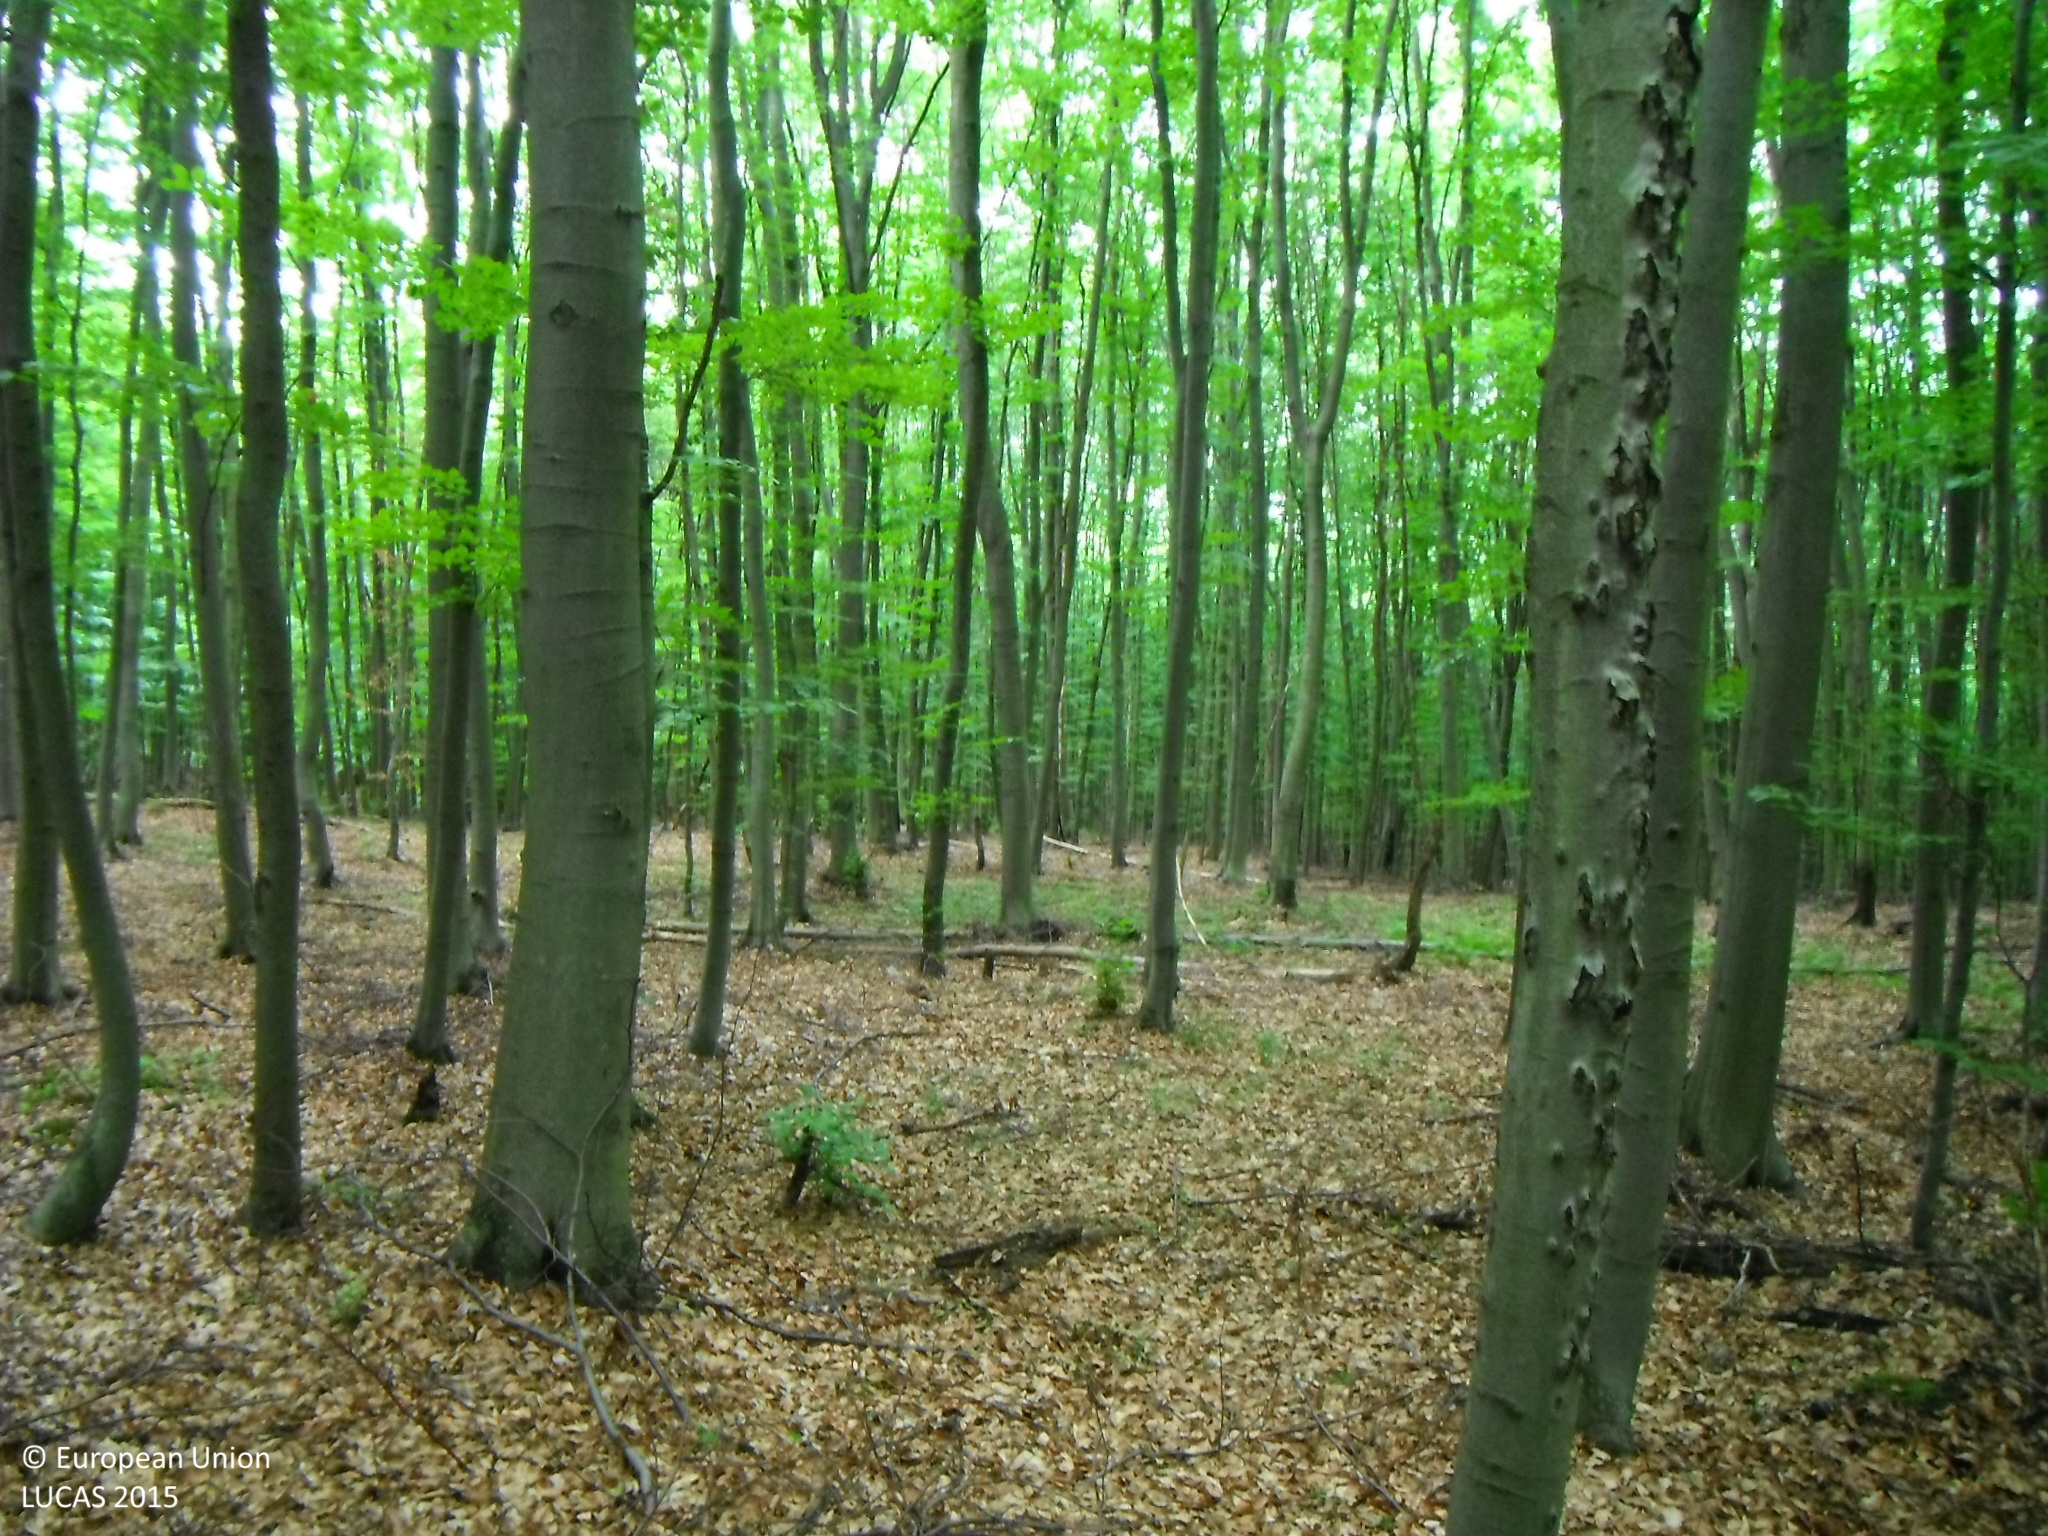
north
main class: Woodland
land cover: Broadleaved woodland
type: beech forest
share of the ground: > 75 %
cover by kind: broadleaved forest trees 100 %
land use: Forestry
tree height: > 5 m
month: June
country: SK
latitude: 49.2677
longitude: 21.5525
